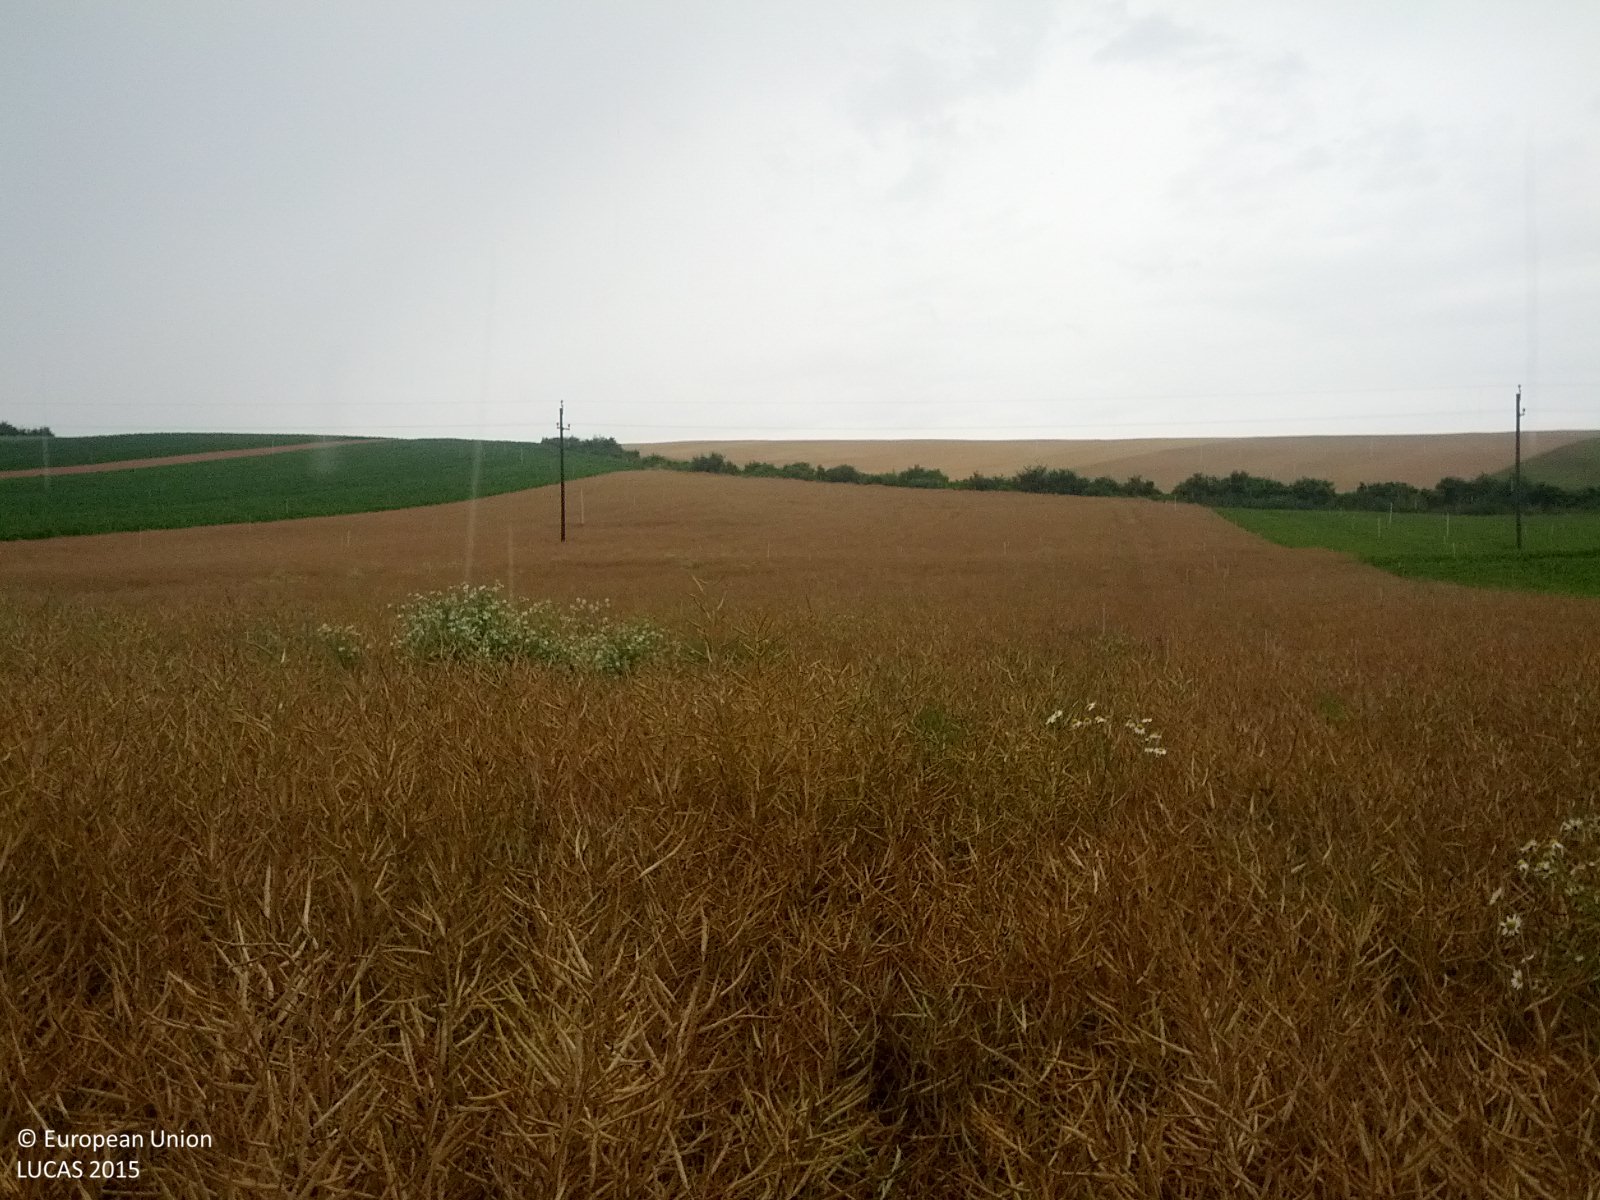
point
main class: Cropland
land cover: Rape and turnip rape
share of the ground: > 75 %
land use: Agriculture (excluding fallow land and kitchen gardens)
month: July
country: AT
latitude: 48.7492
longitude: 16.5758
